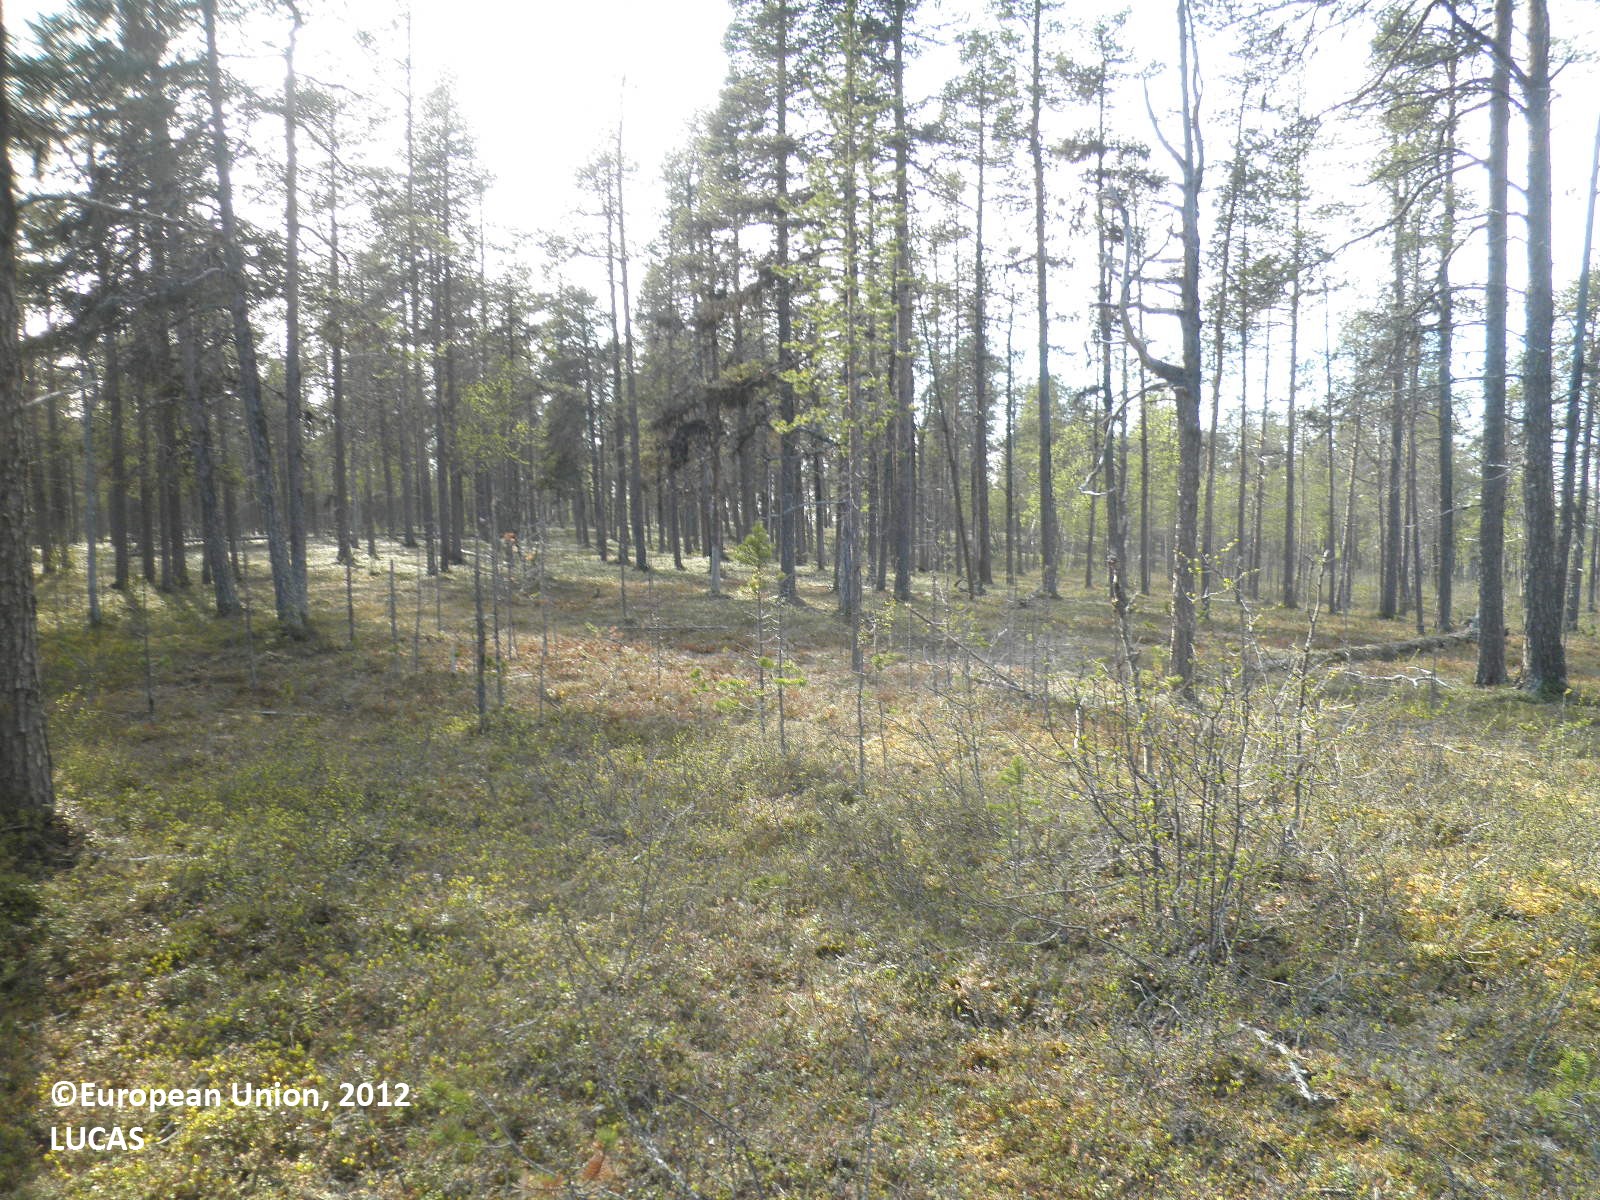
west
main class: Woodland
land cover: Pine dominated coniferous woodland
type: boreal forest
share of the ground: 25 - 50 %
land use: Forestry
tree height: > 5 m
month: June
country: FI
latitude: 68.9058
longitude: 26.2498
